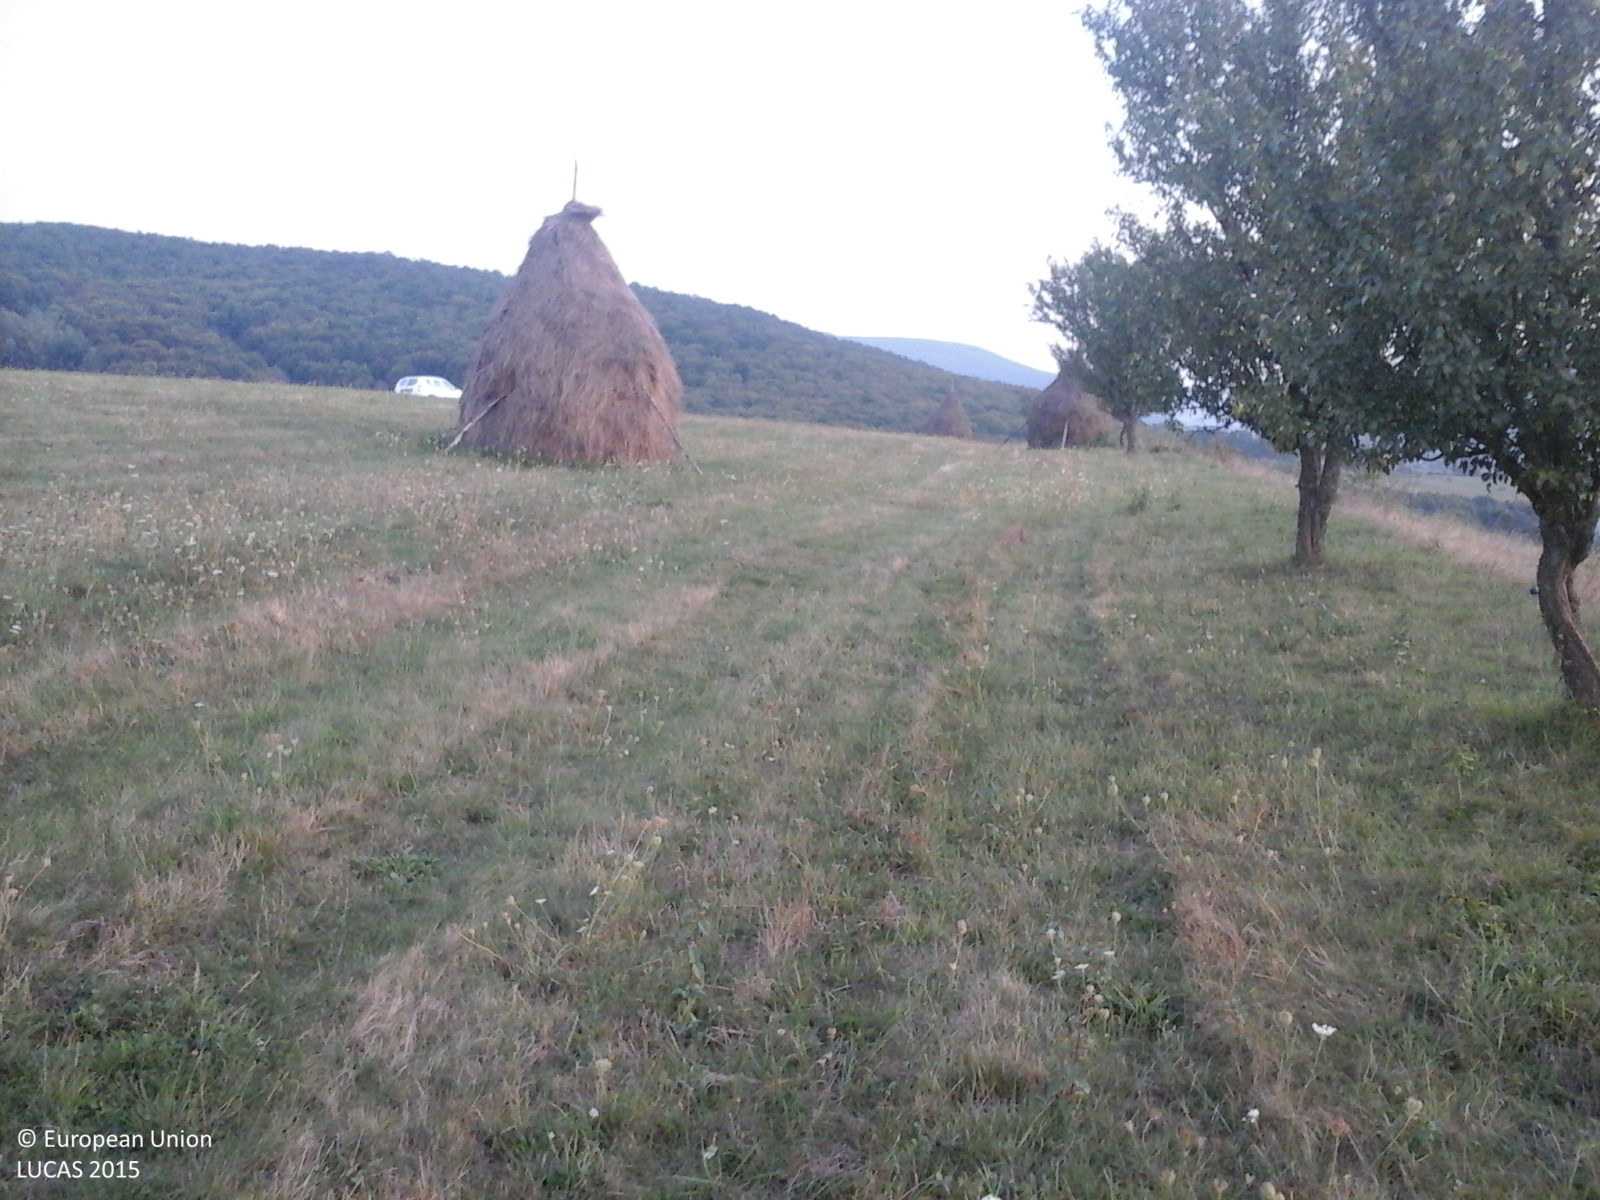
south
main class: Grassland
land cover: Grassland without tree/shrub cover
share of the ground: > 75 %
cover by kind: herbaceous plants 100 %
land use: Agriculture (excluding fallow land and kitchen gardens)
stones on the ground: < 10 %
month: September
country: RO
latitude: 47.2480
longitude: 23.8863
